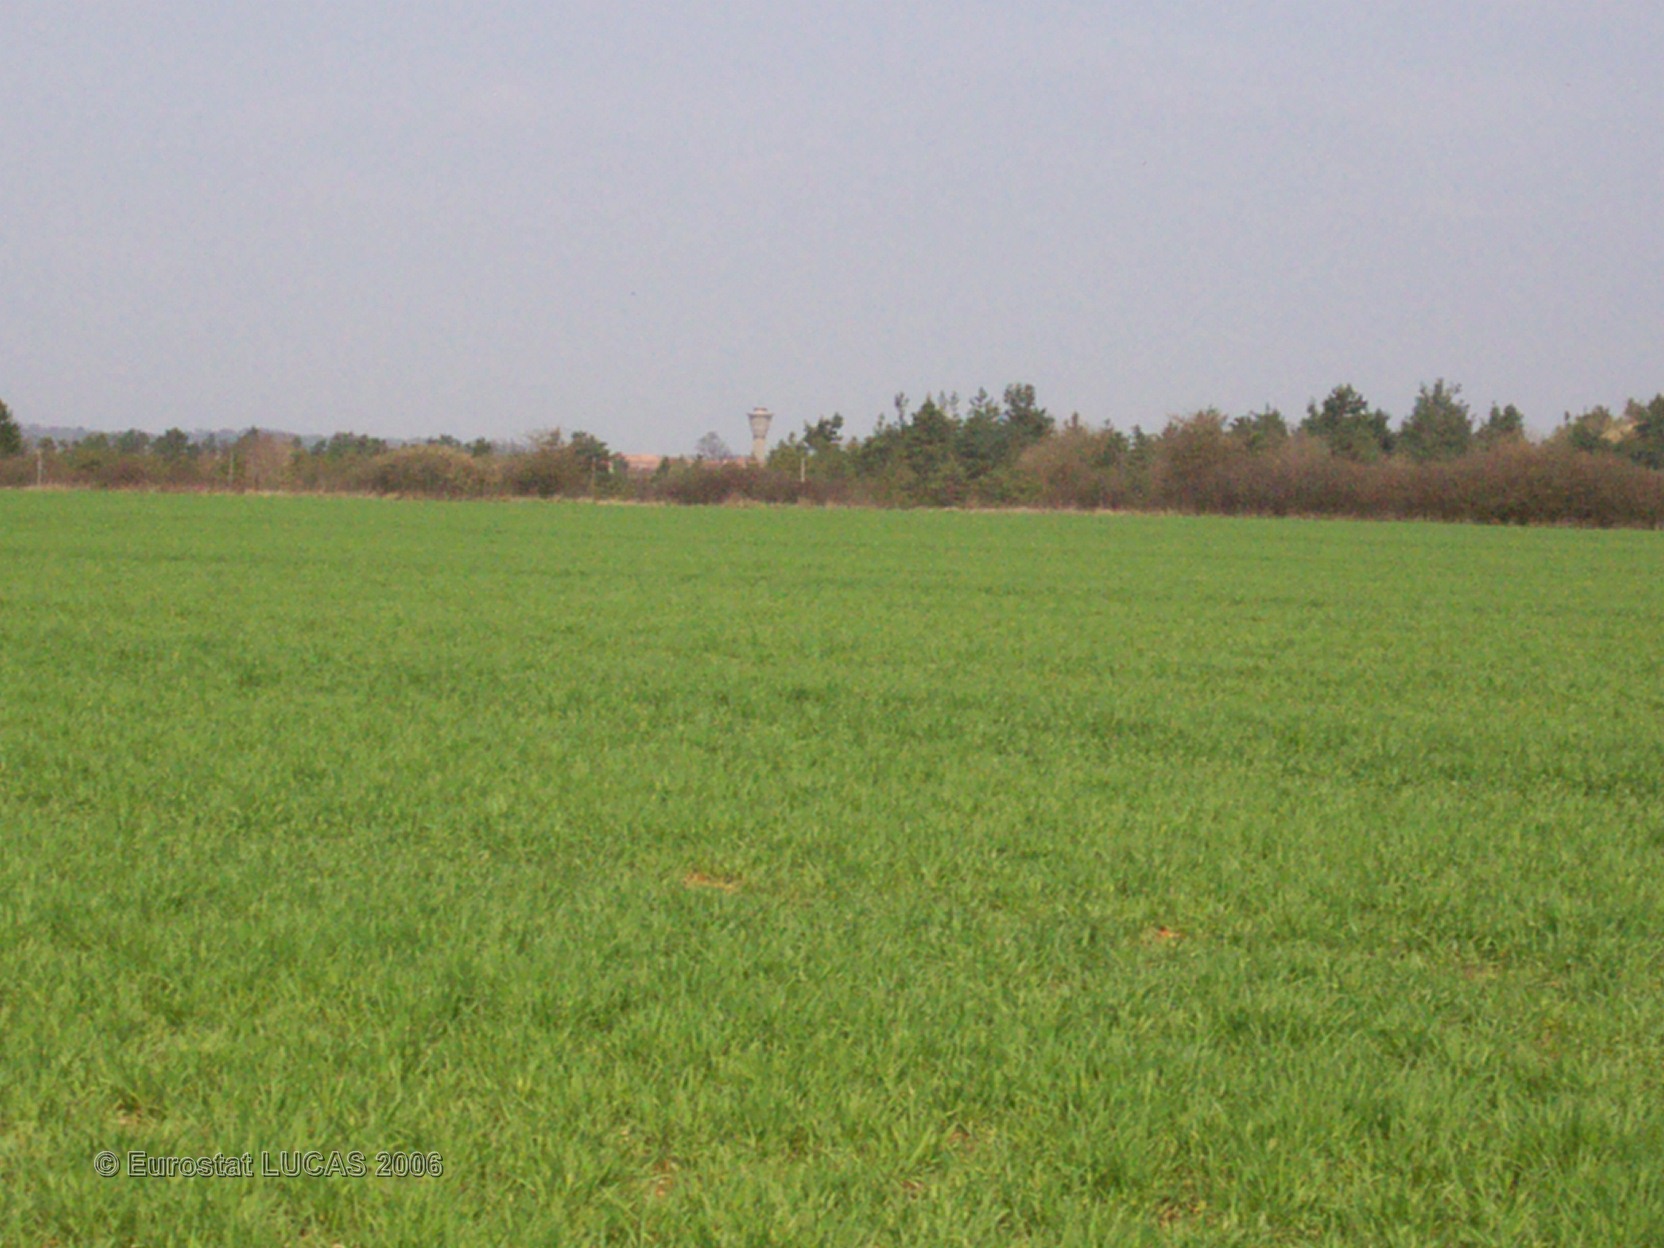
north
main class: Cropland
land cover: Barley
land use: Agriculture (excluding fallow land and kitchen gardens)
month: April
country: FR
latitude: 48.7441
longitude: 5.9608
